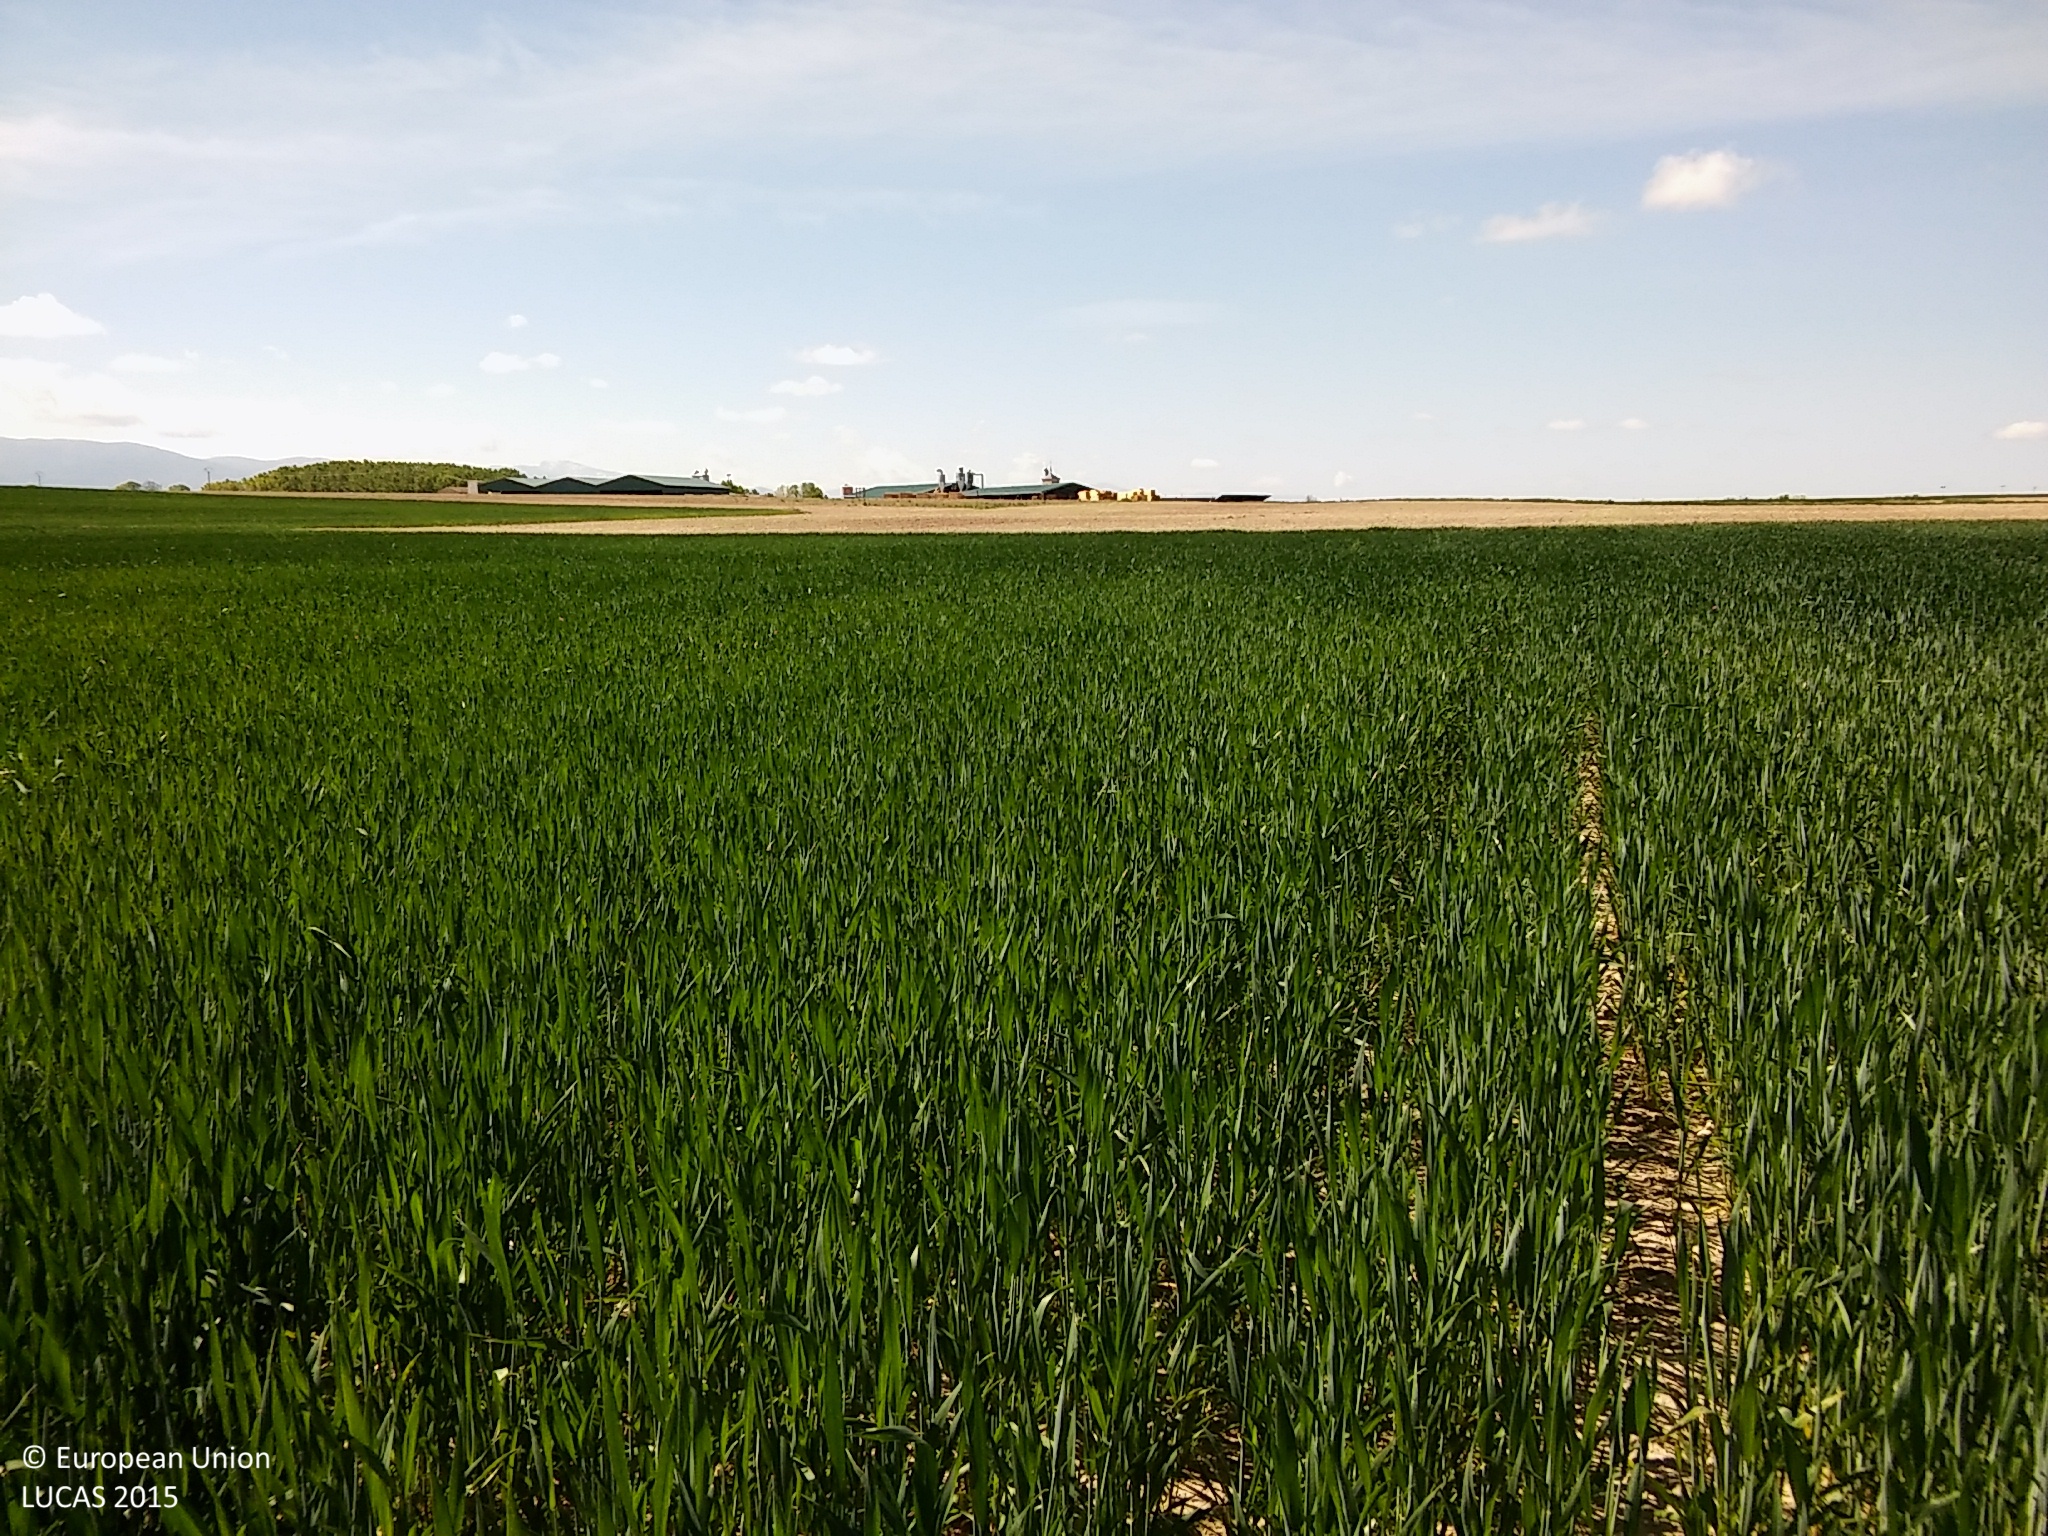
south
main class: Cropland
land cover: Common wheat
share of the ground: > 75 %
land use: Agriculture (excluding fallow land and kitchen gardens)
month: May
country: ES
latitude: 41.2014
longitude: -3.9918
